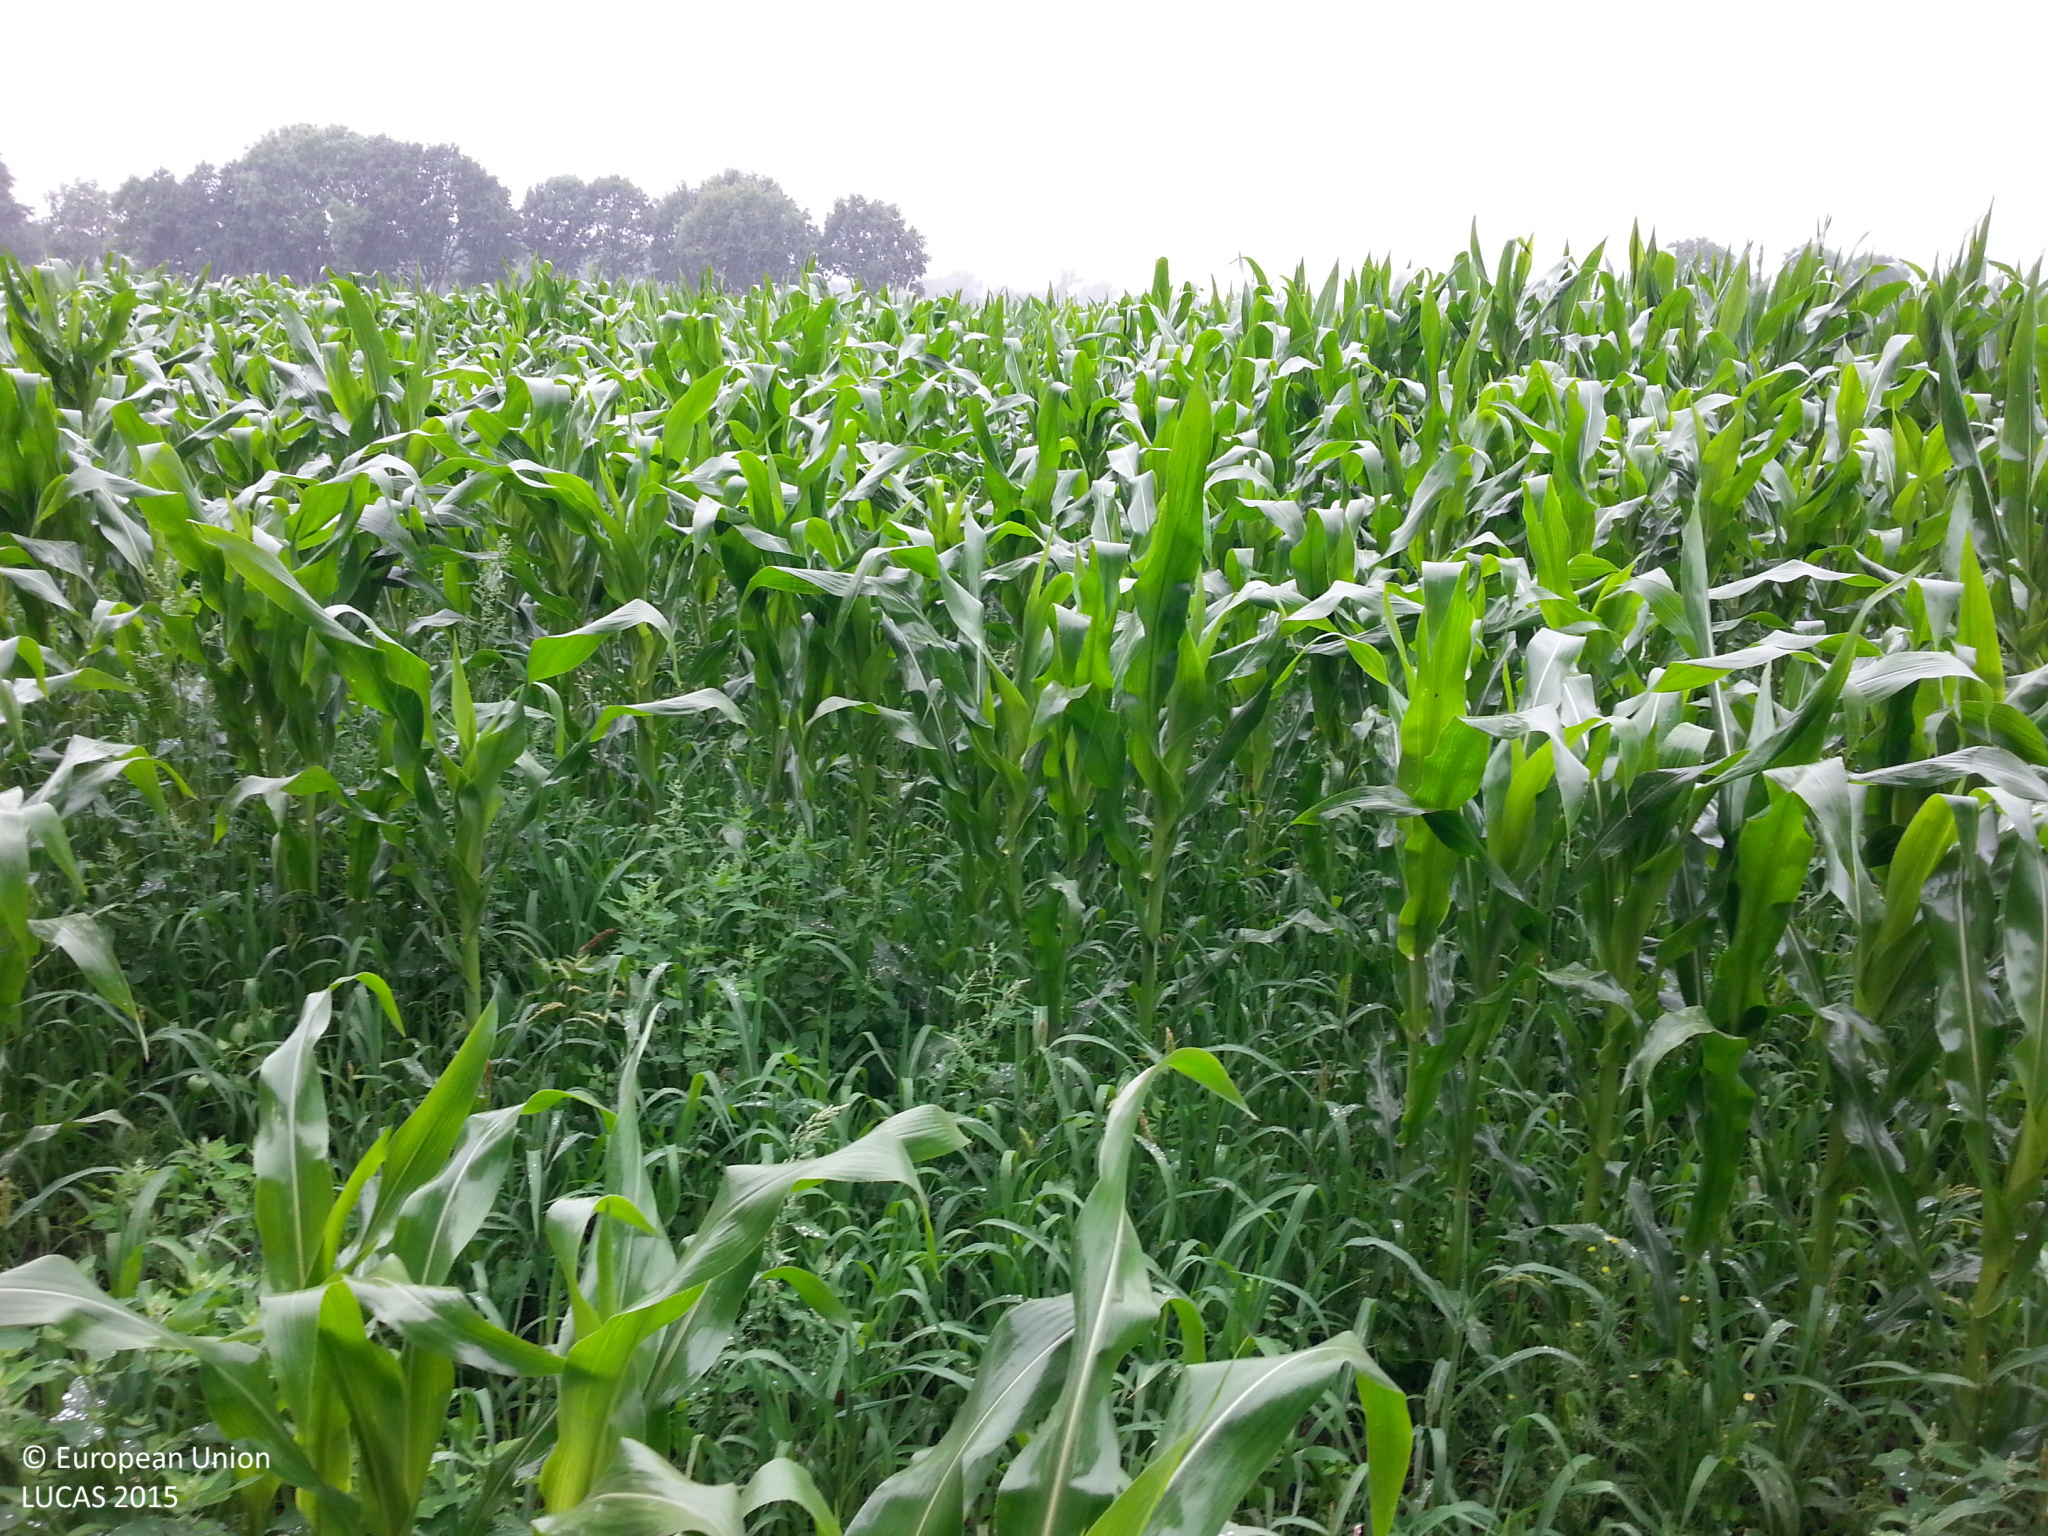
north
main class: Cropland
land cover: Maize
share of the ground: > 75 %
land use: Agriculture (excluding fallow land and kitchen gardens)
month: July
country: DE
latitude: 53.0201
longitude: 11.0282
